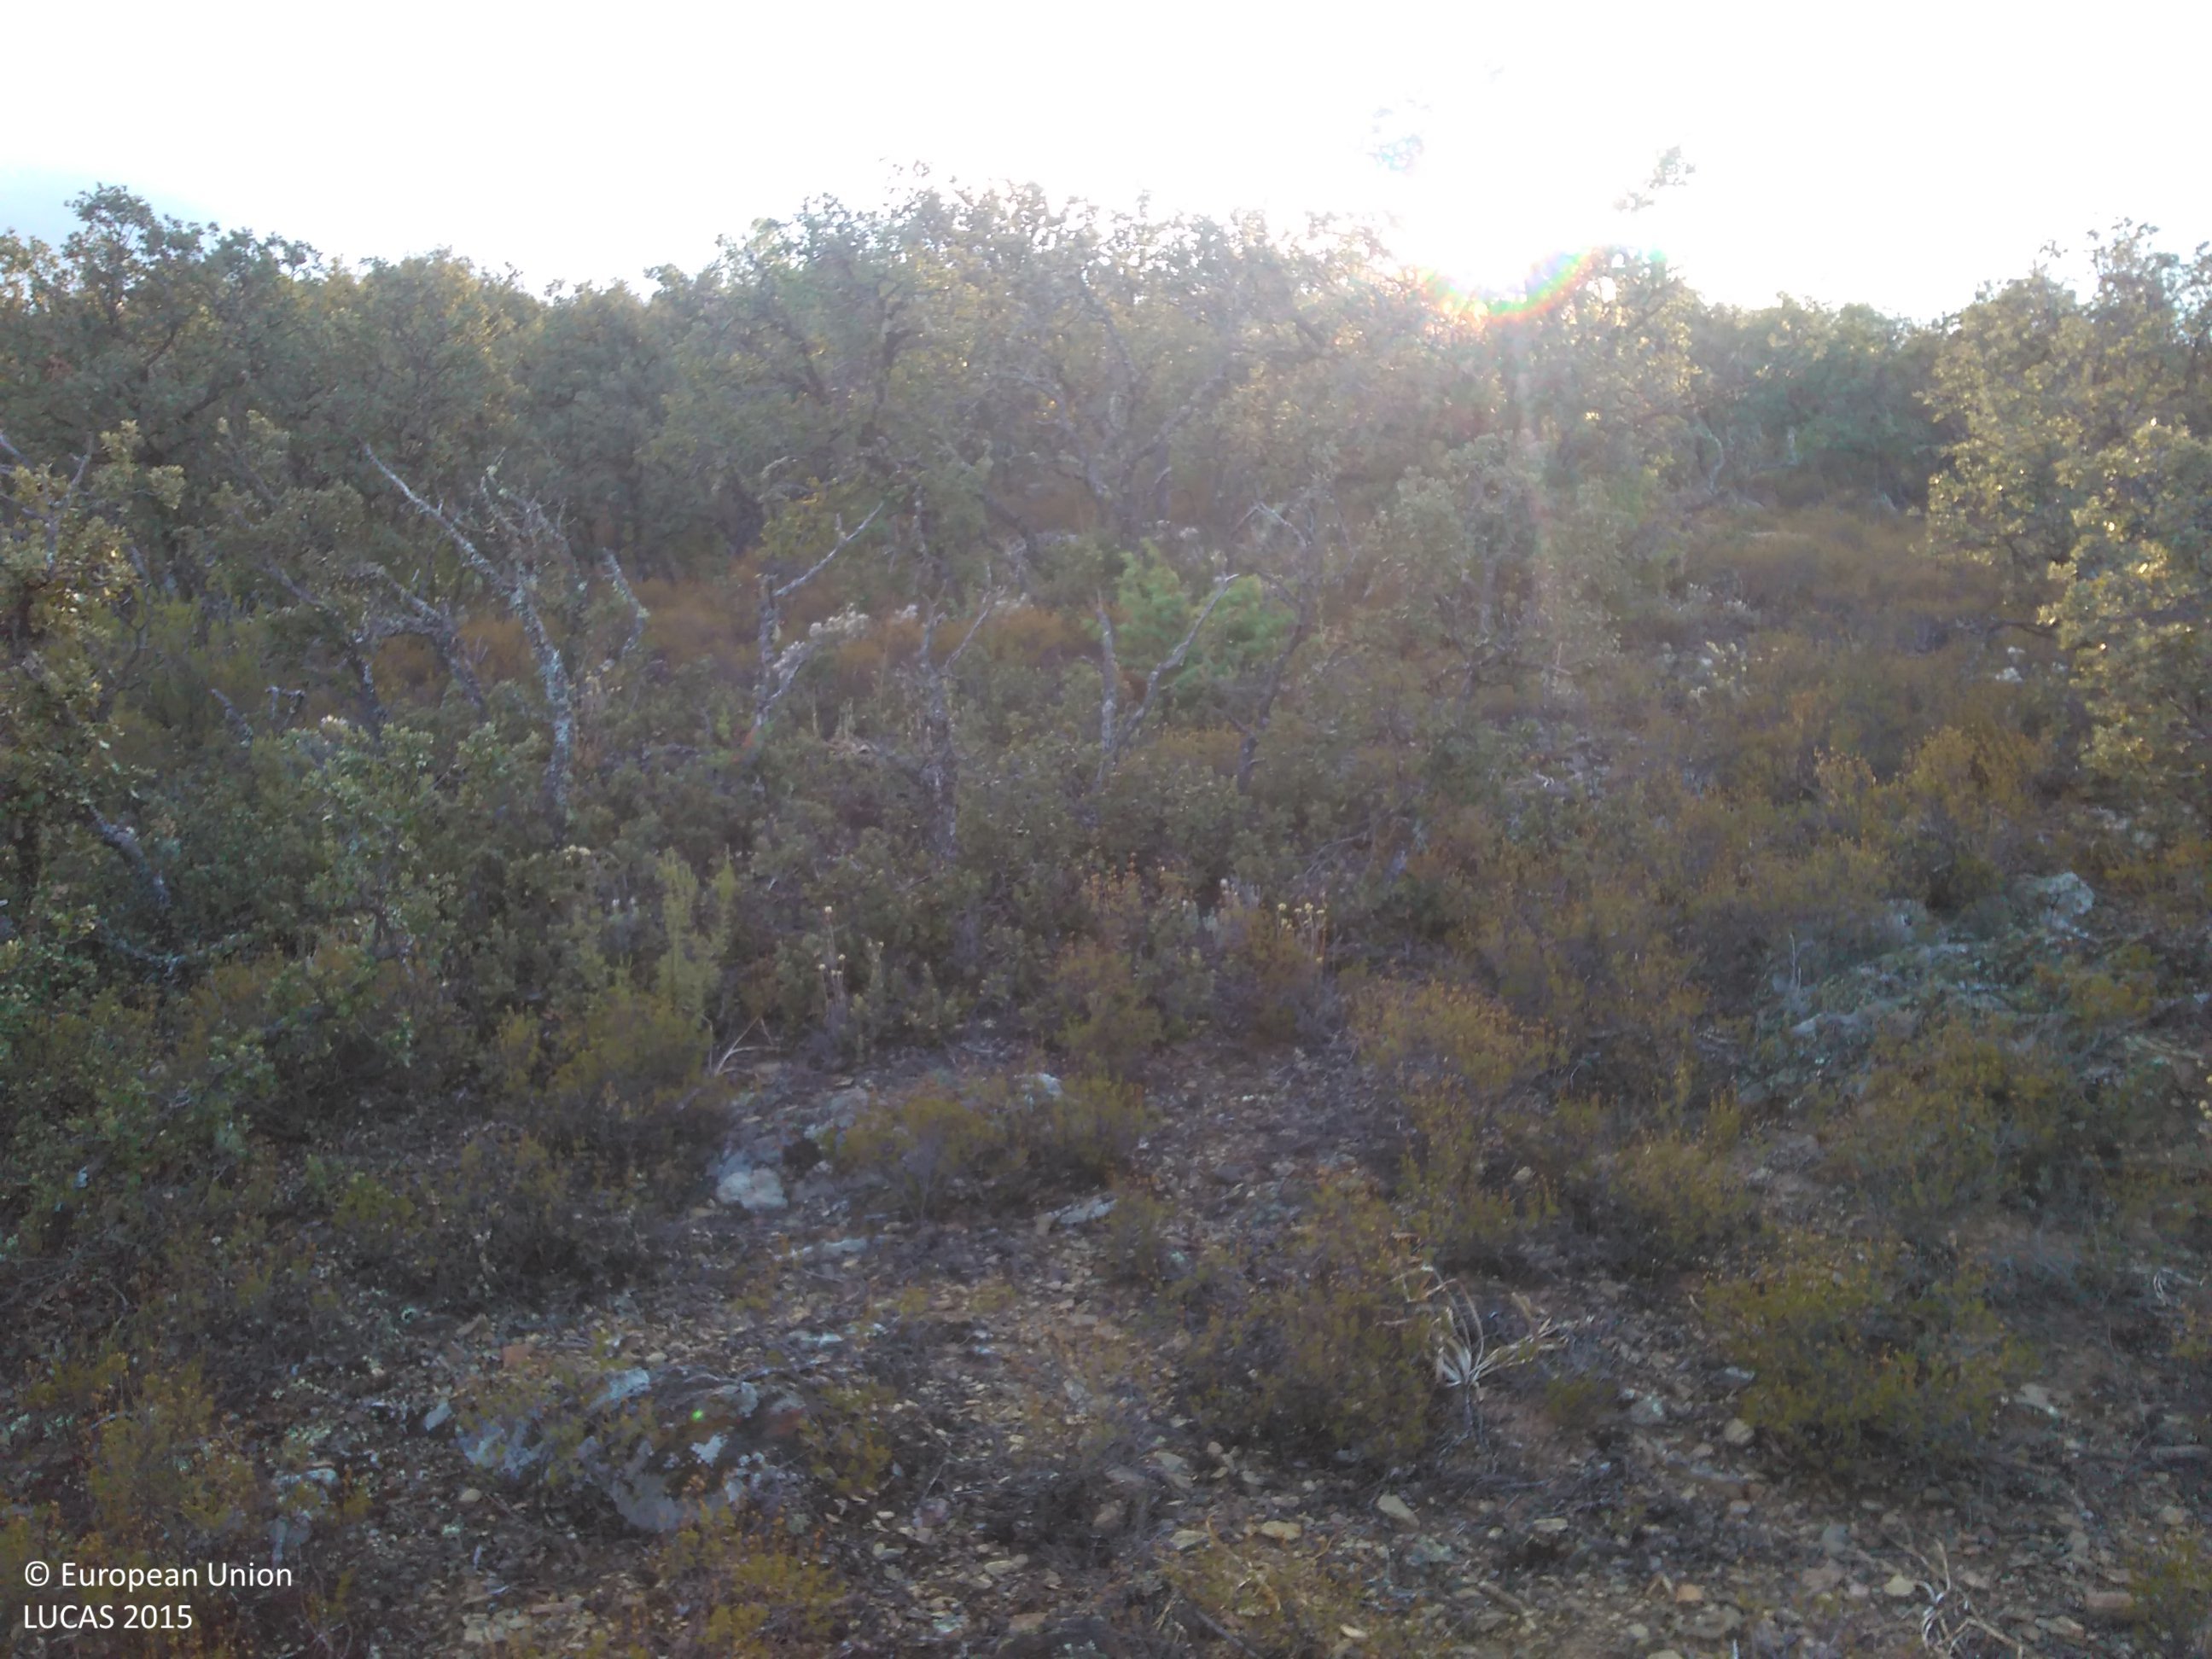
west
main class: Woodland
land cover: Broadleaved woodland
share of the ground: 50 - 75 %
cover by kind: broadleaved forest trees 50 %, shrubs 30 %, unconsolidated bare surface 20 %
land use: Semi-natural and natural areas not in use
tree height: < 5 m
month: July
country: ES
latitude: 41.4226
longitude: -1.8858
